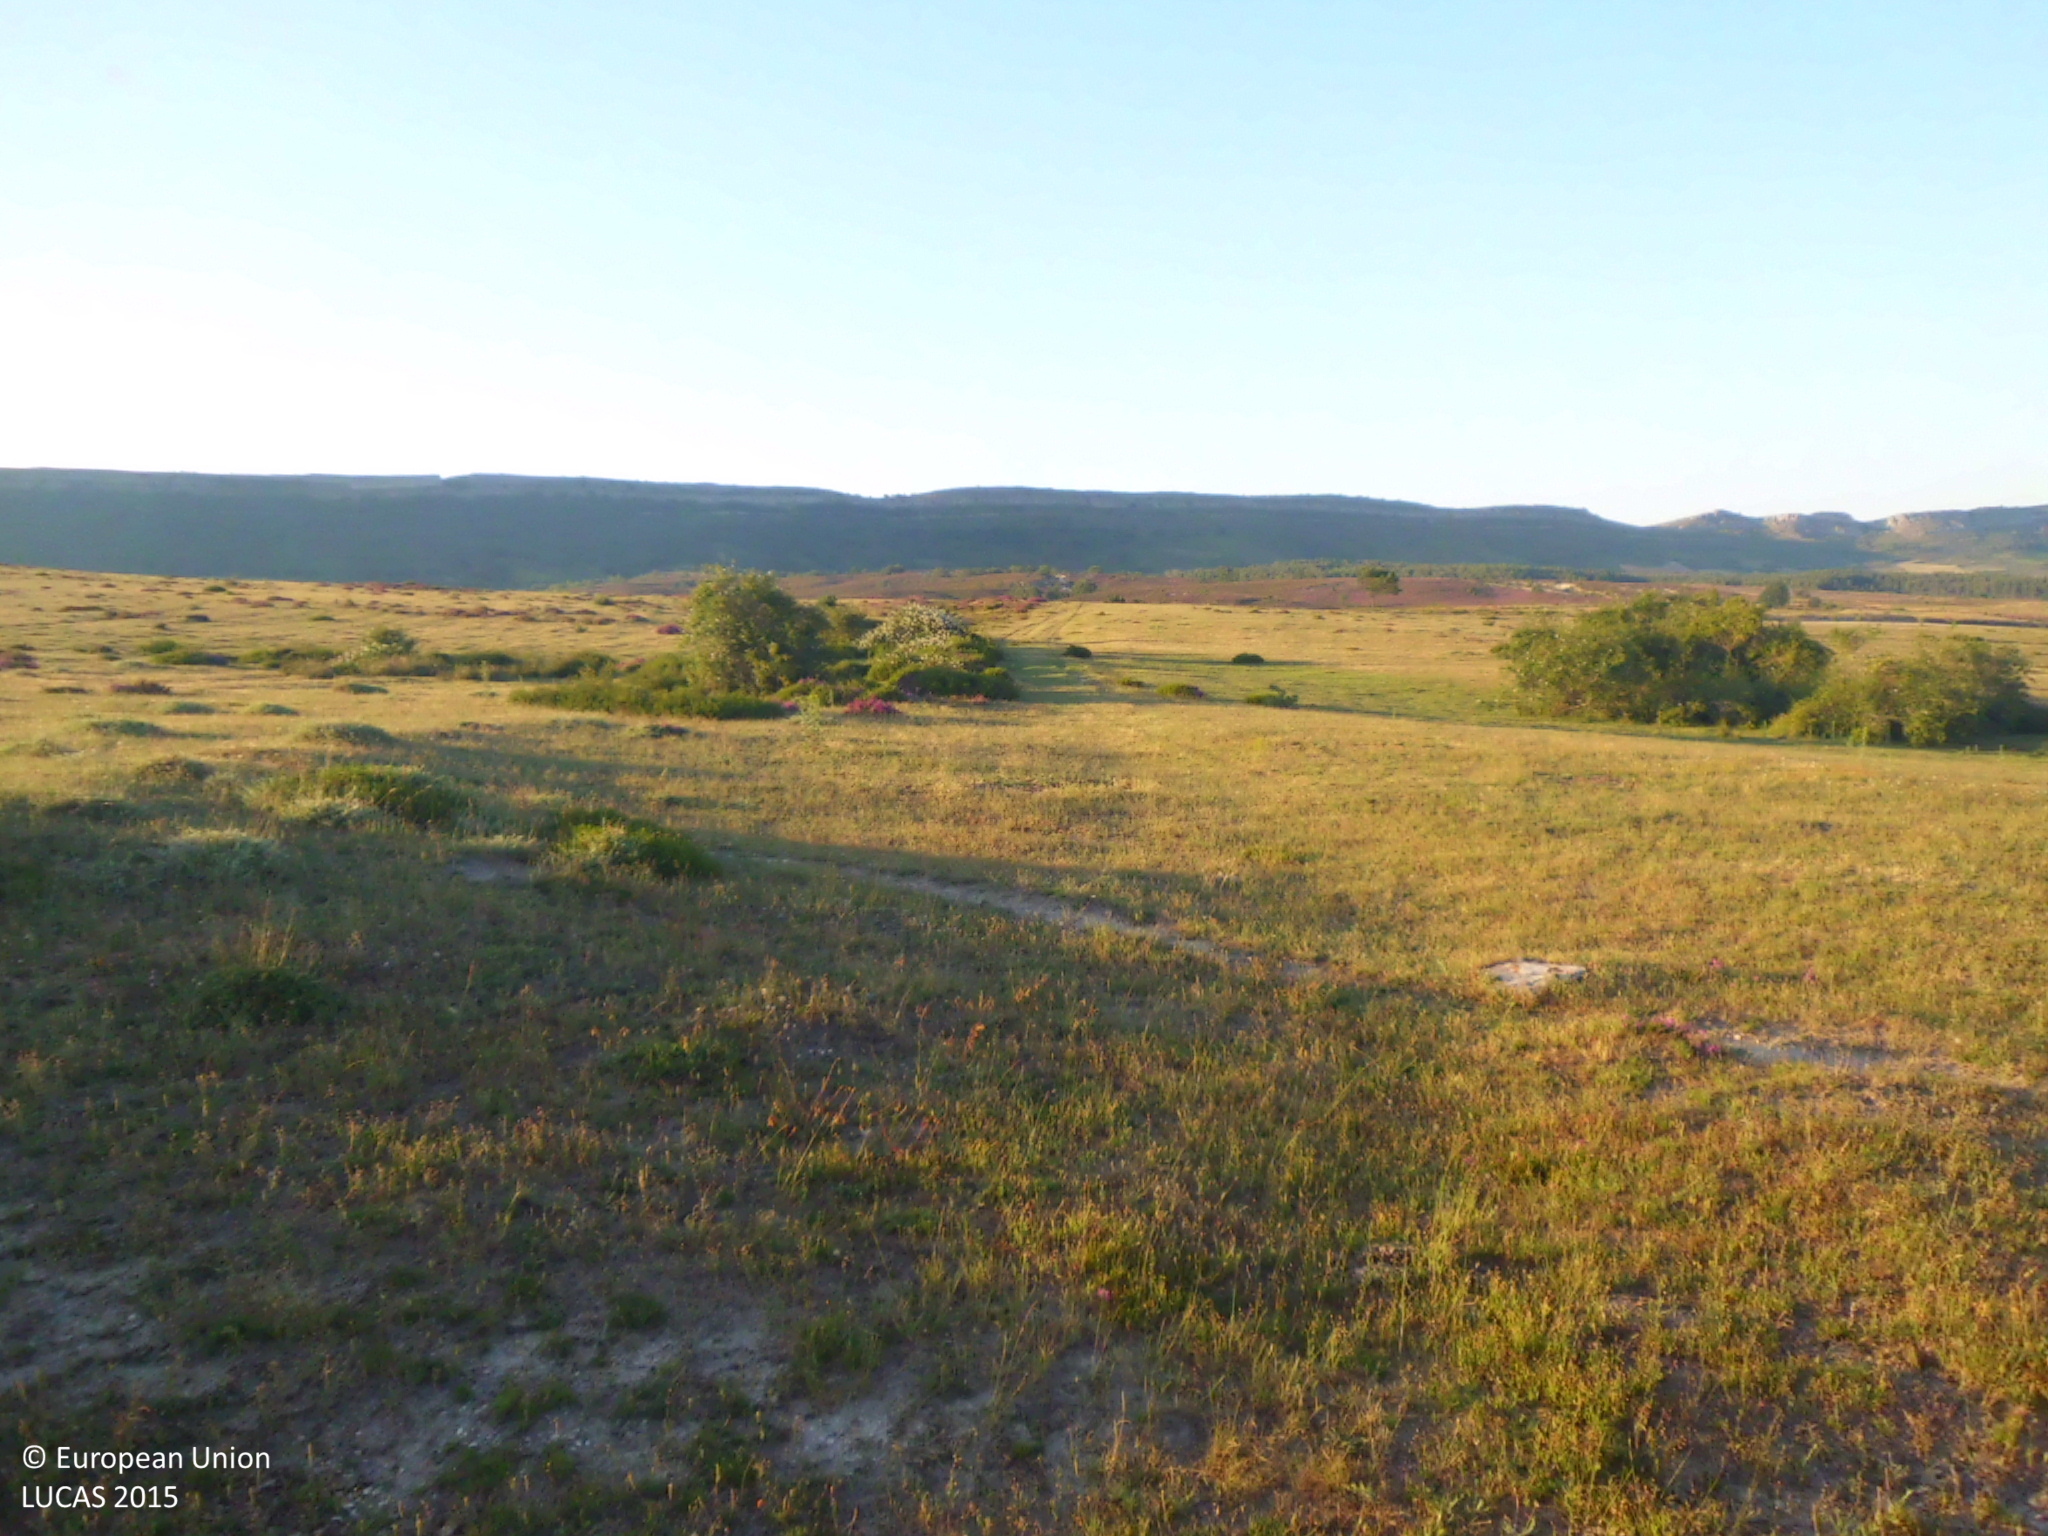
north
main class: Grassland
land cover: Grassland without tree/shrub cover
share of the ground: > 75 %
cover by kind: herbaceous plants 85 %, consolidated bare surface 15 %
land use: Agriculture (excluding fallow land and kitchen gardens)
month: June
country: ES
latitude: 42.6127
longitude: -3.9771
